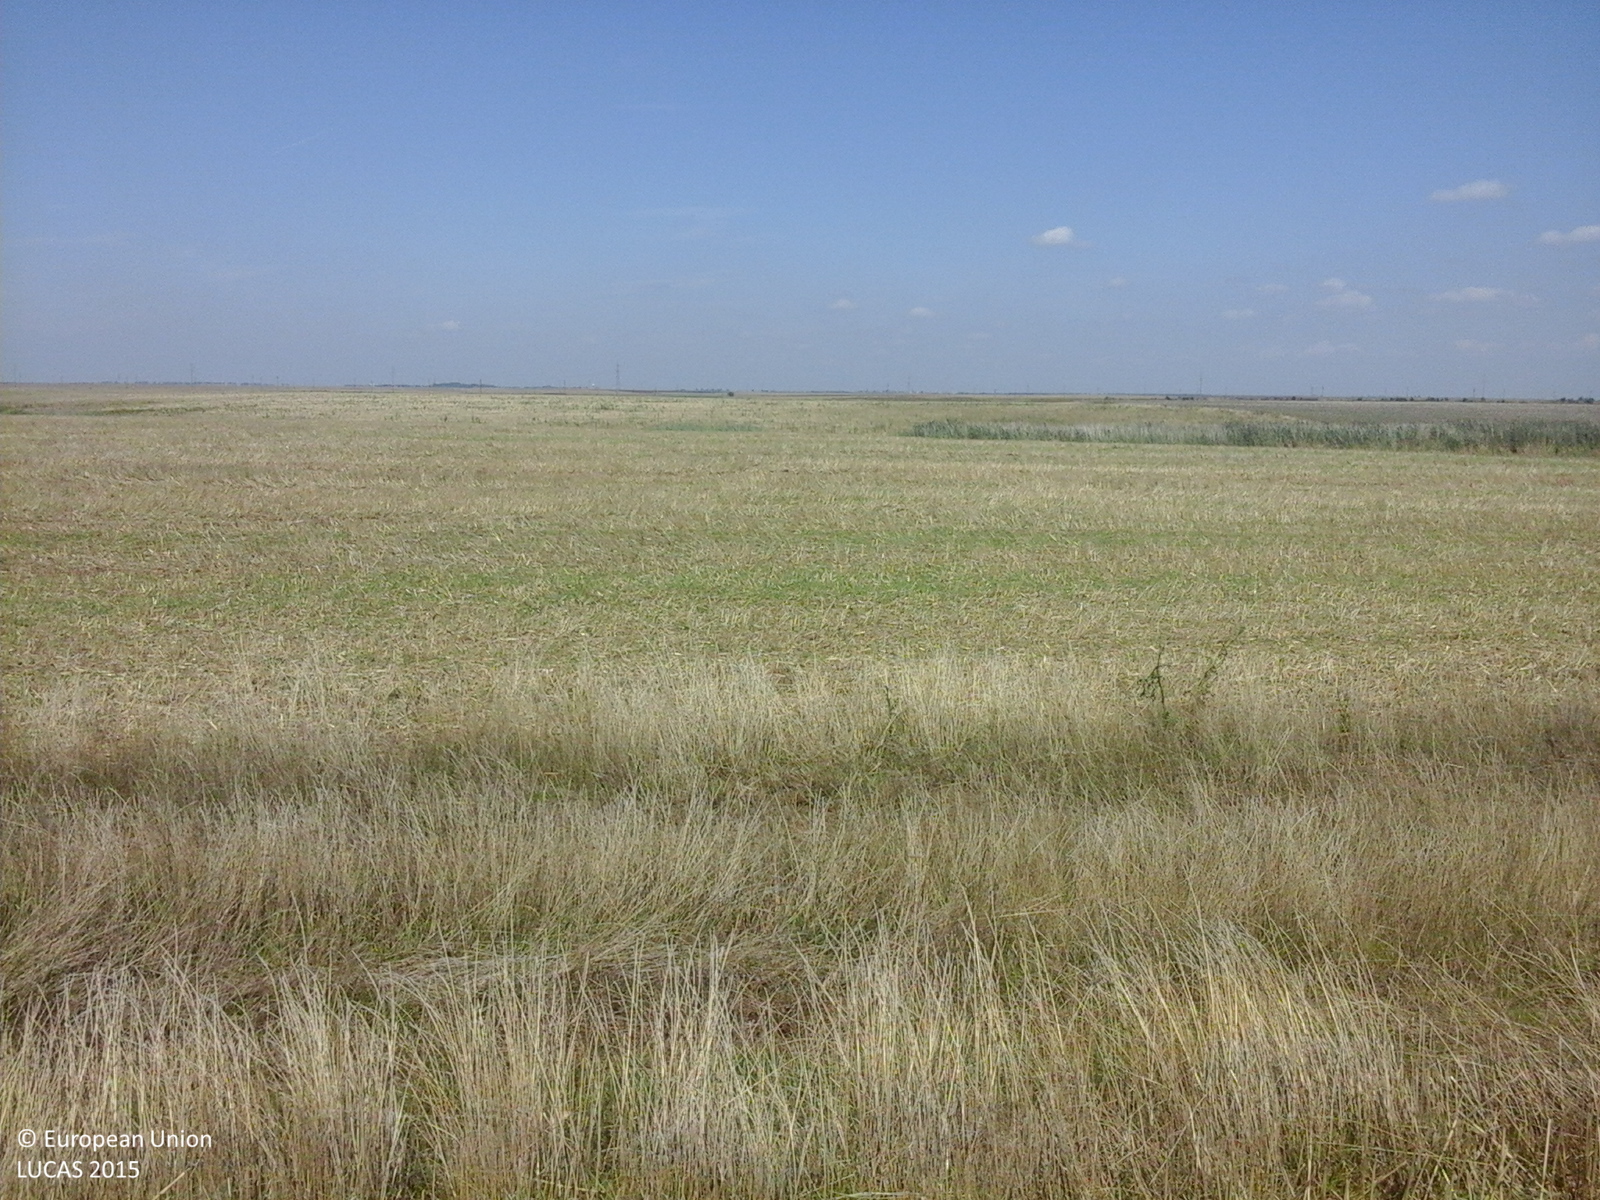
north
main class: Cropland
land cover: Common wheat
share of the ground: 50 - 75 %
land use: Agriculture (excluding fallow land and kitchen gardens)
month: August
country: RO
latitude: 45.9466
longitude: 21.1636
